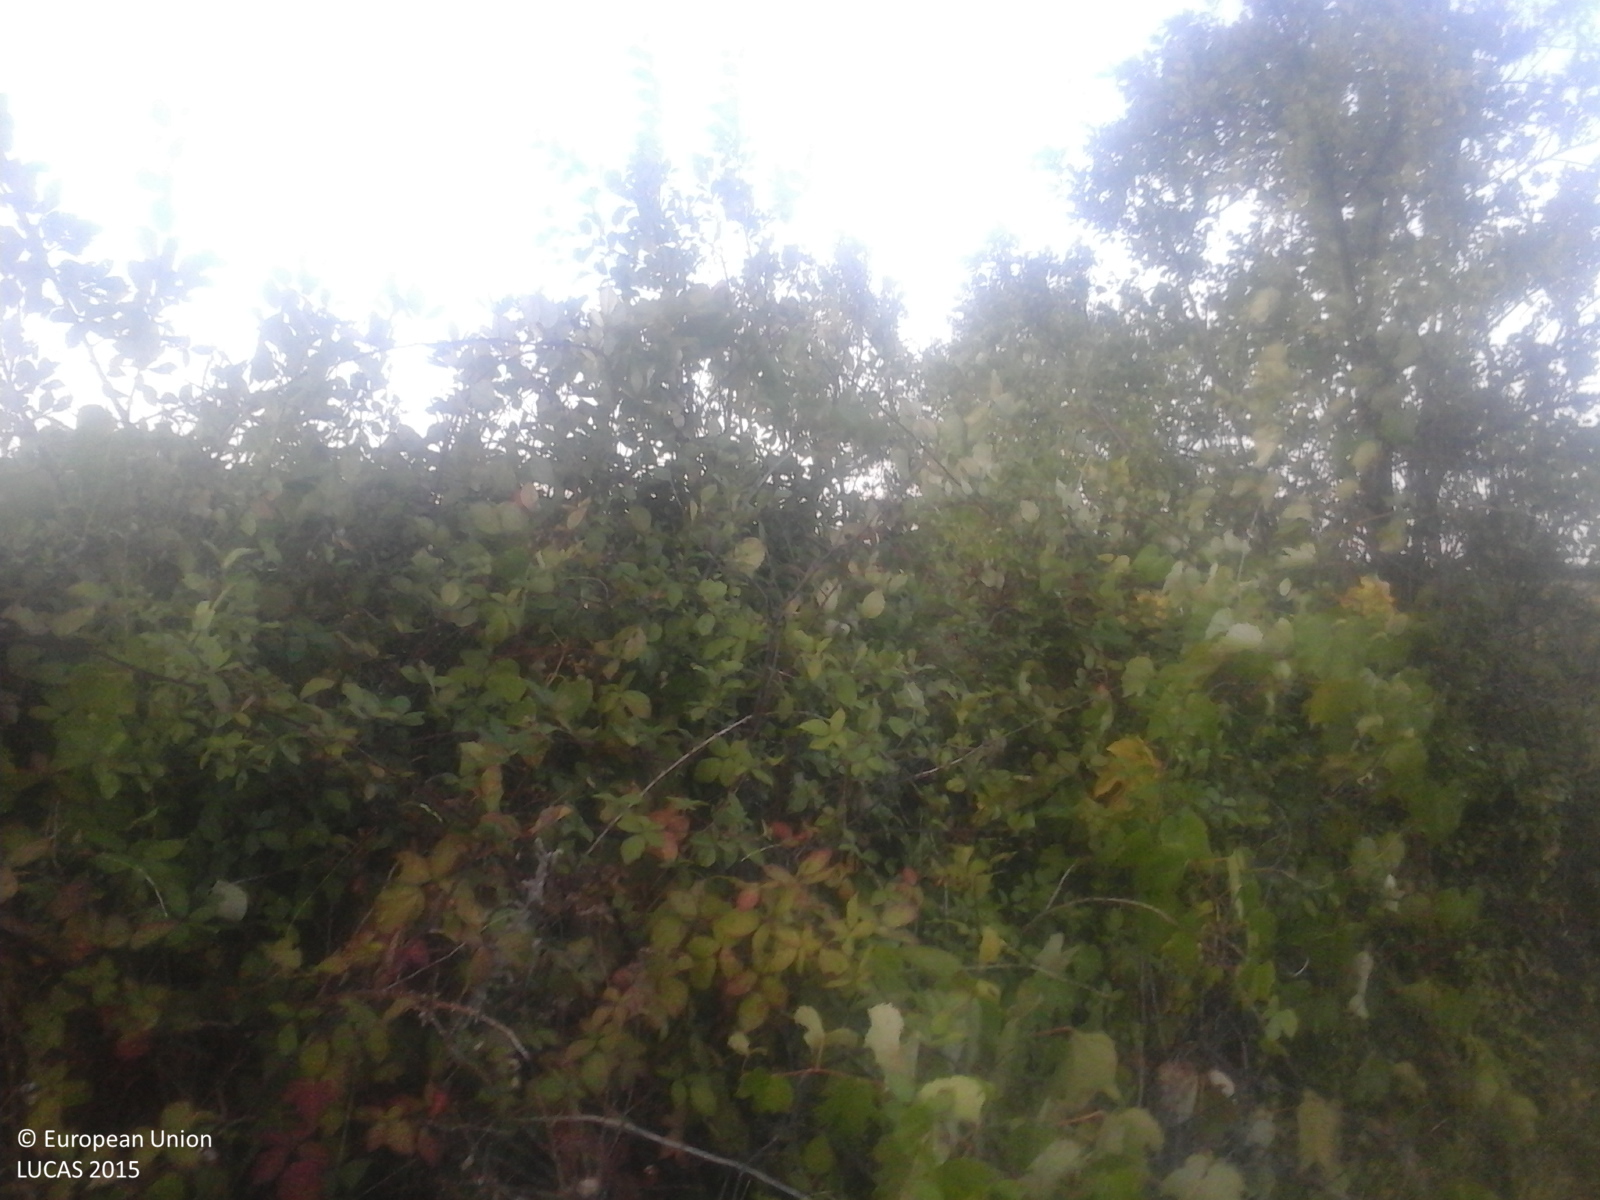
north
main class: Grassland
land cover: Spontaneously vegetated surfaces
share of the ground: > 75 %
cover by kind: herbaceous plants 100 %
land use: Fallow land
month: September
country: RO
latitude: 46.5935
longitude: 22.3850
